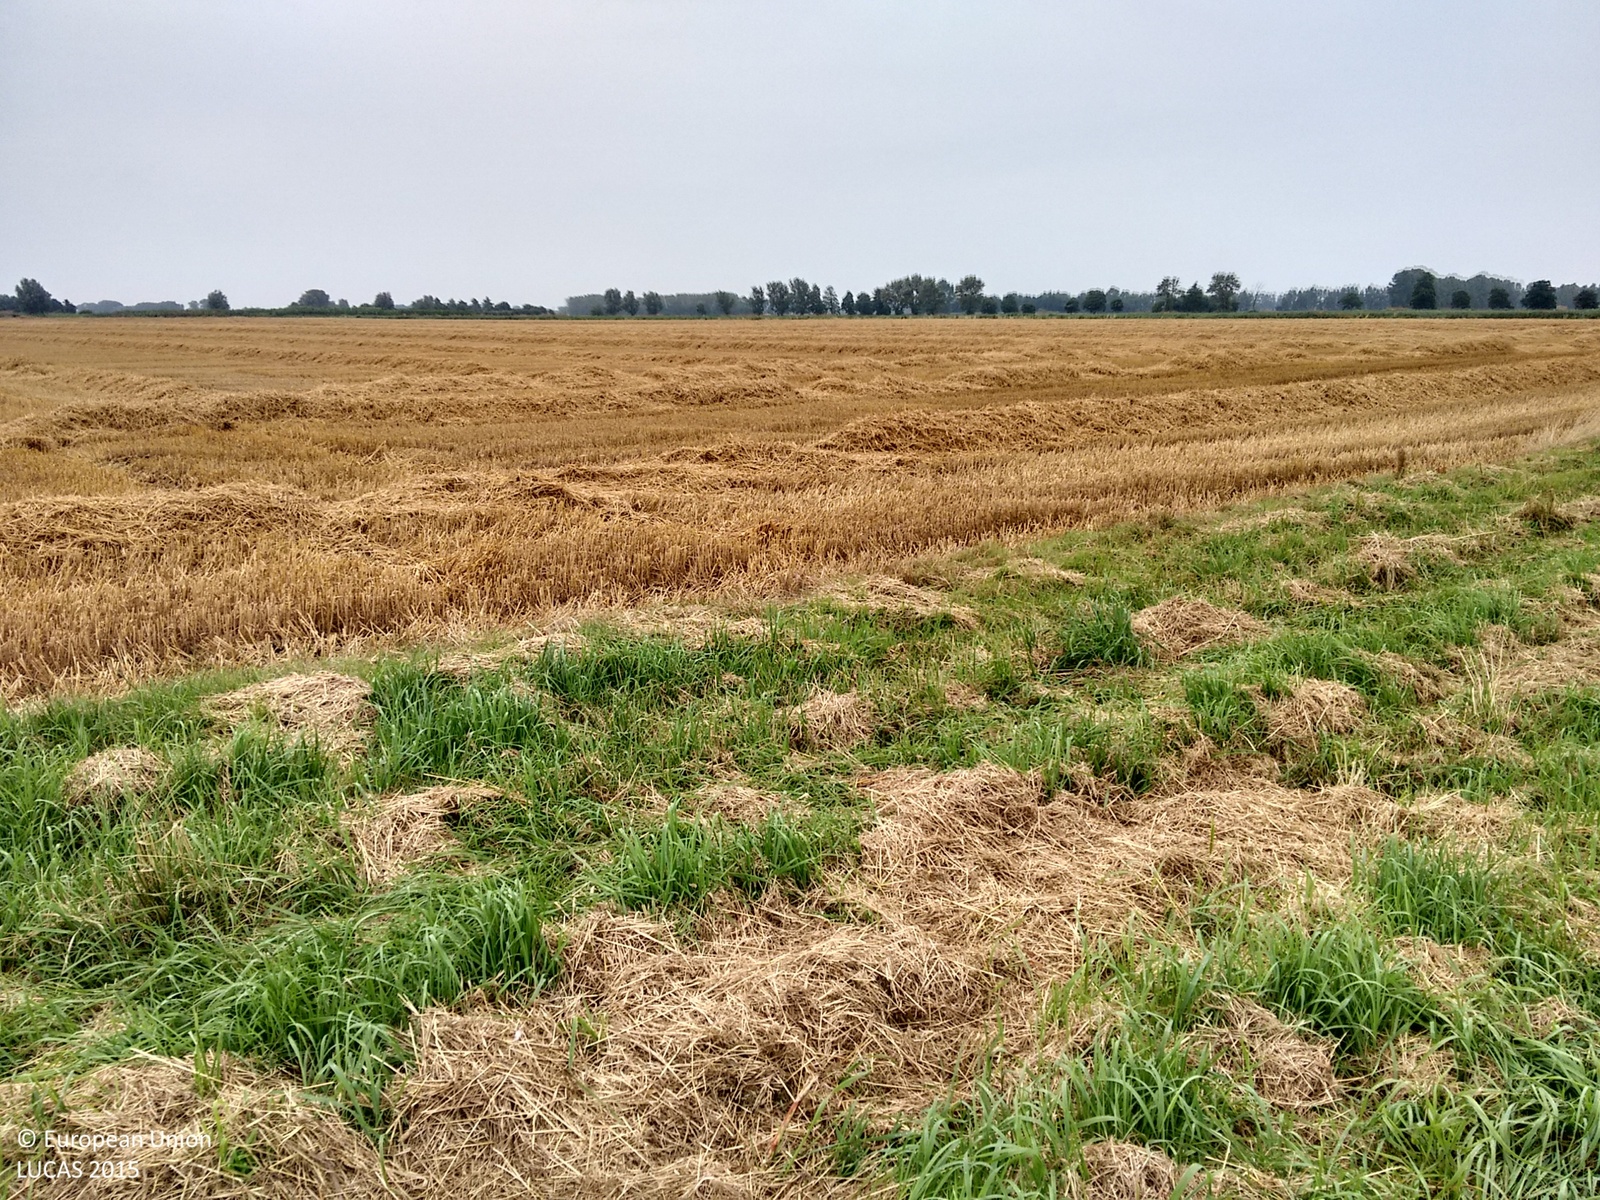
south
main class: Grassland
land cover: Grassland without tree/shrub cover
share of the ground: > 75 %
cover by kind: herbaceous plants 100 %
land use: Agriculture (excluding fallow land and kitchen gardens)
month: August
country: GB
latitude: 52.3841
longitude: 0.3773
